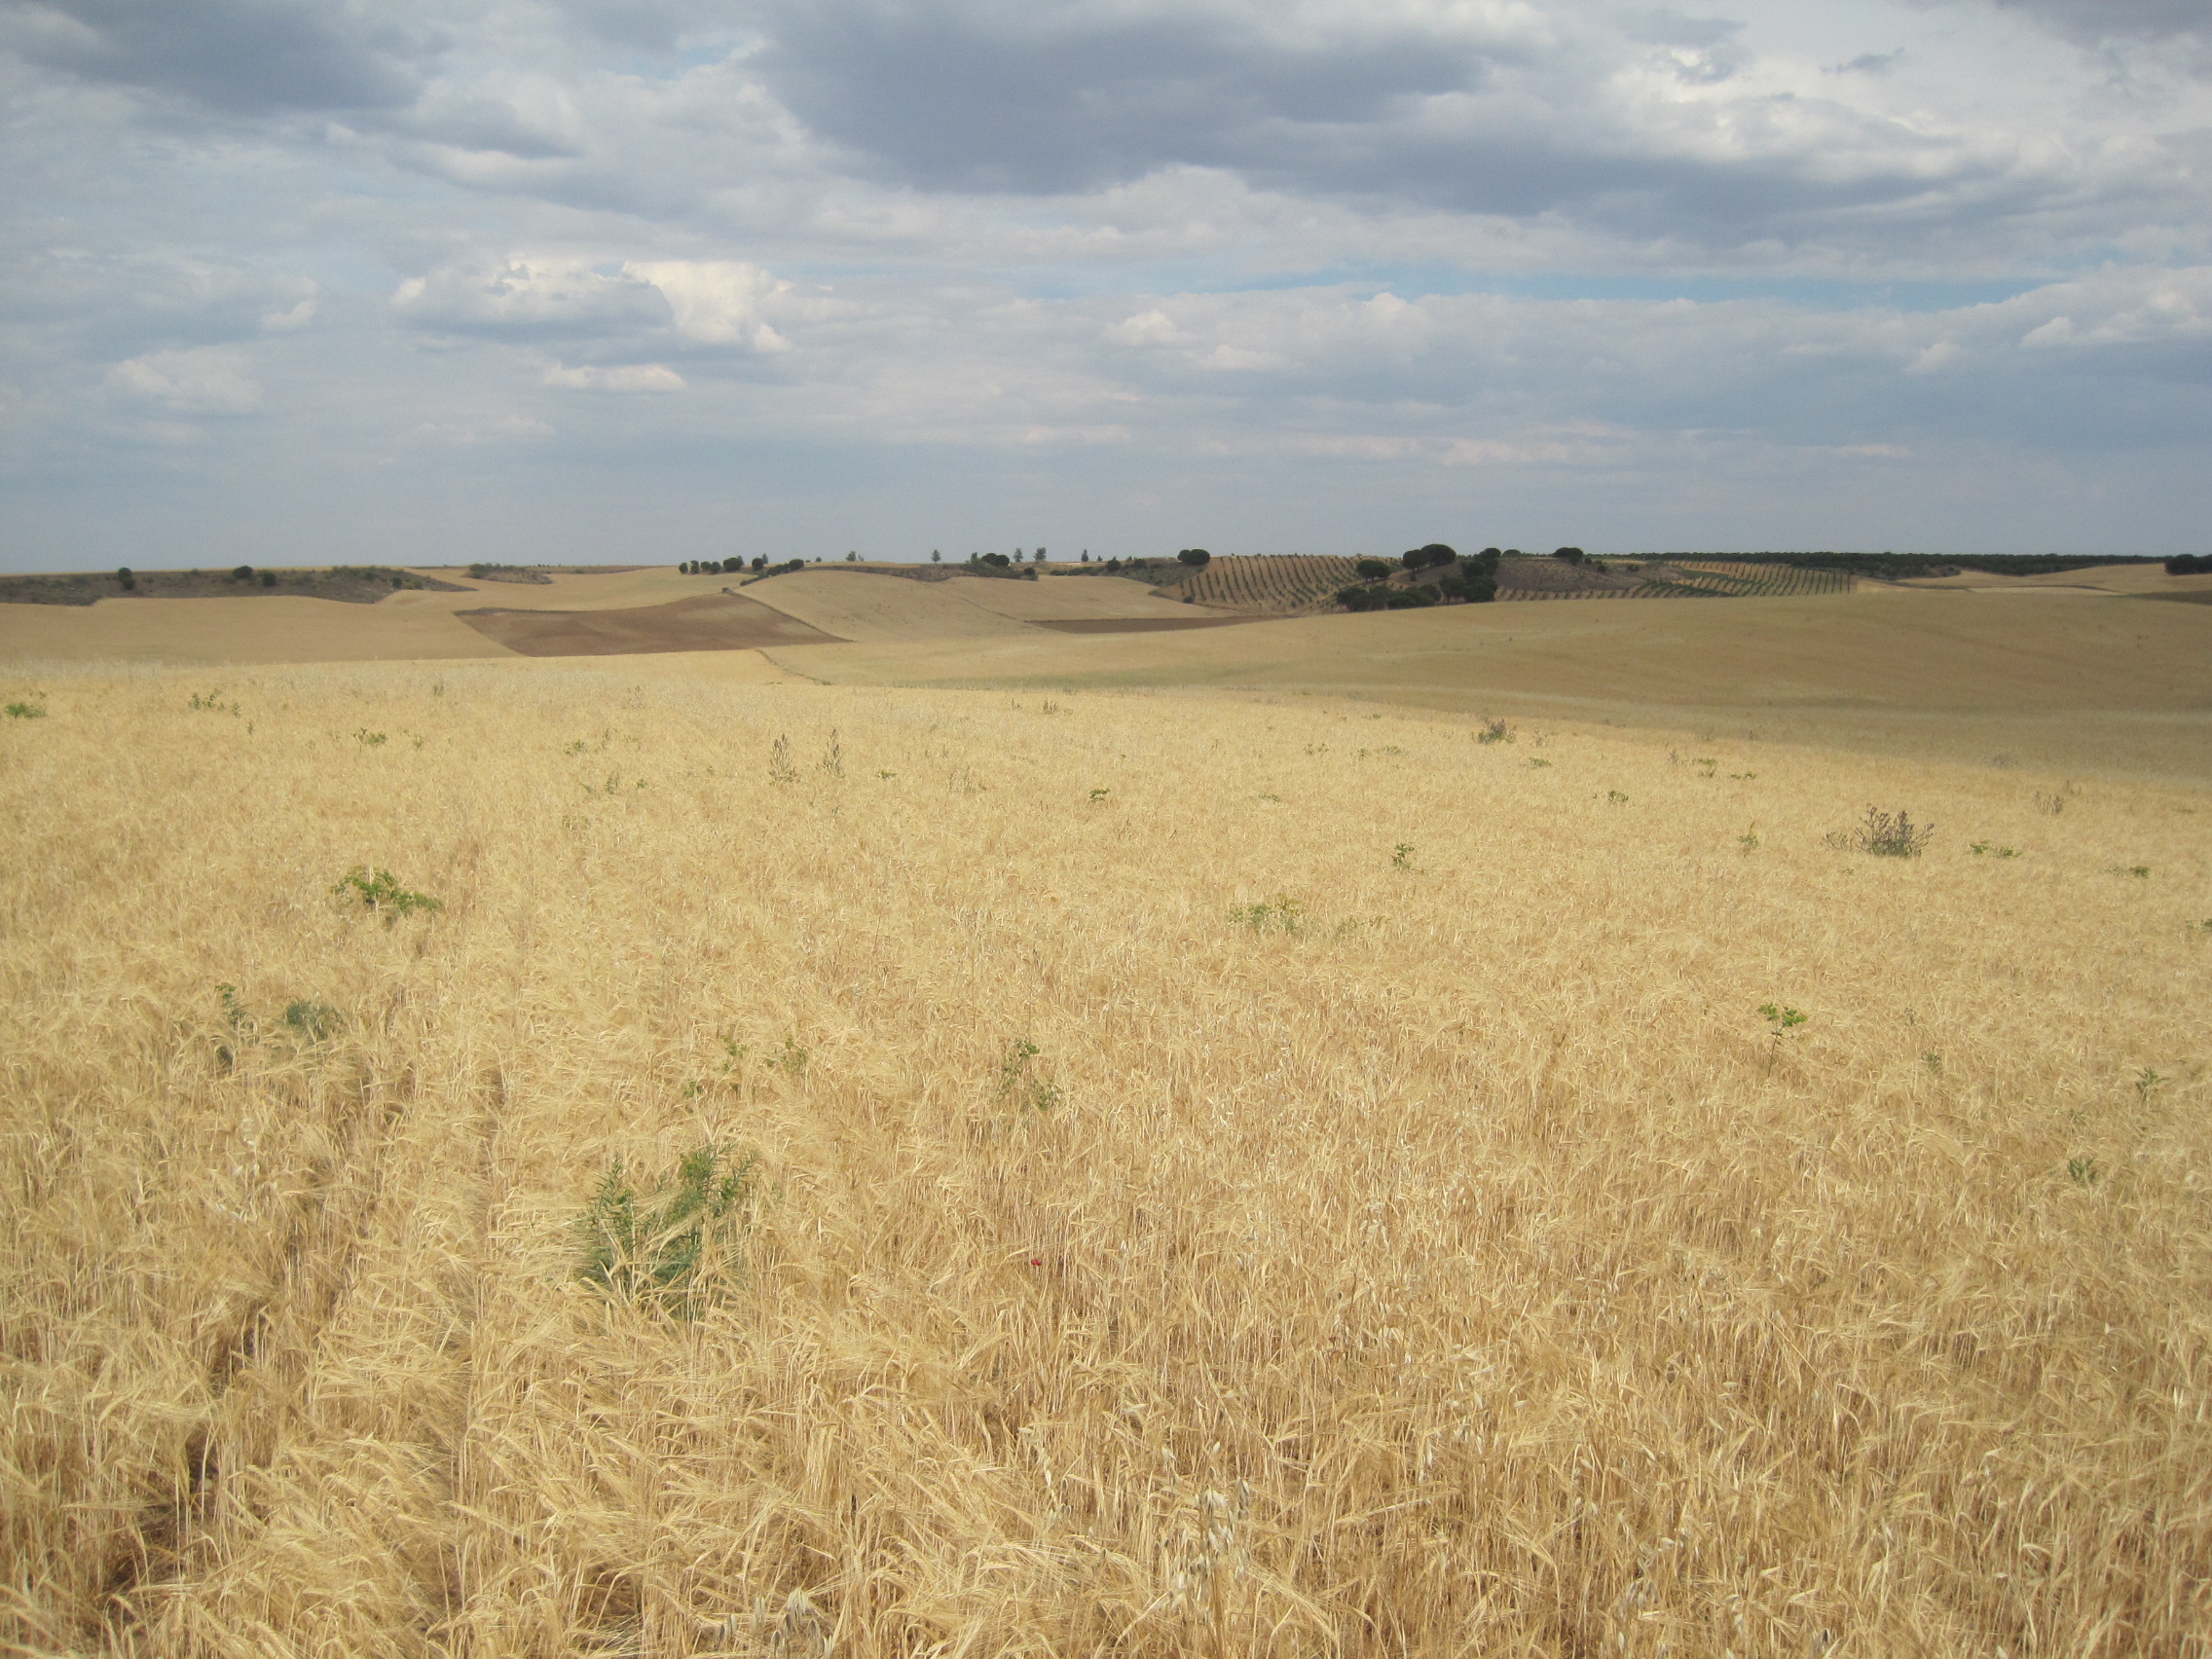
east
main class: Cropland
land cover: Barley
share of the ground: > 75 %
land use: Agriculture (excluding fallow land and kitchen gardens)
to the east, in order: Barley; Grass margins; Common wheat
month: June
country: ES
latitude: 41.3926
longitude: -5.0572
